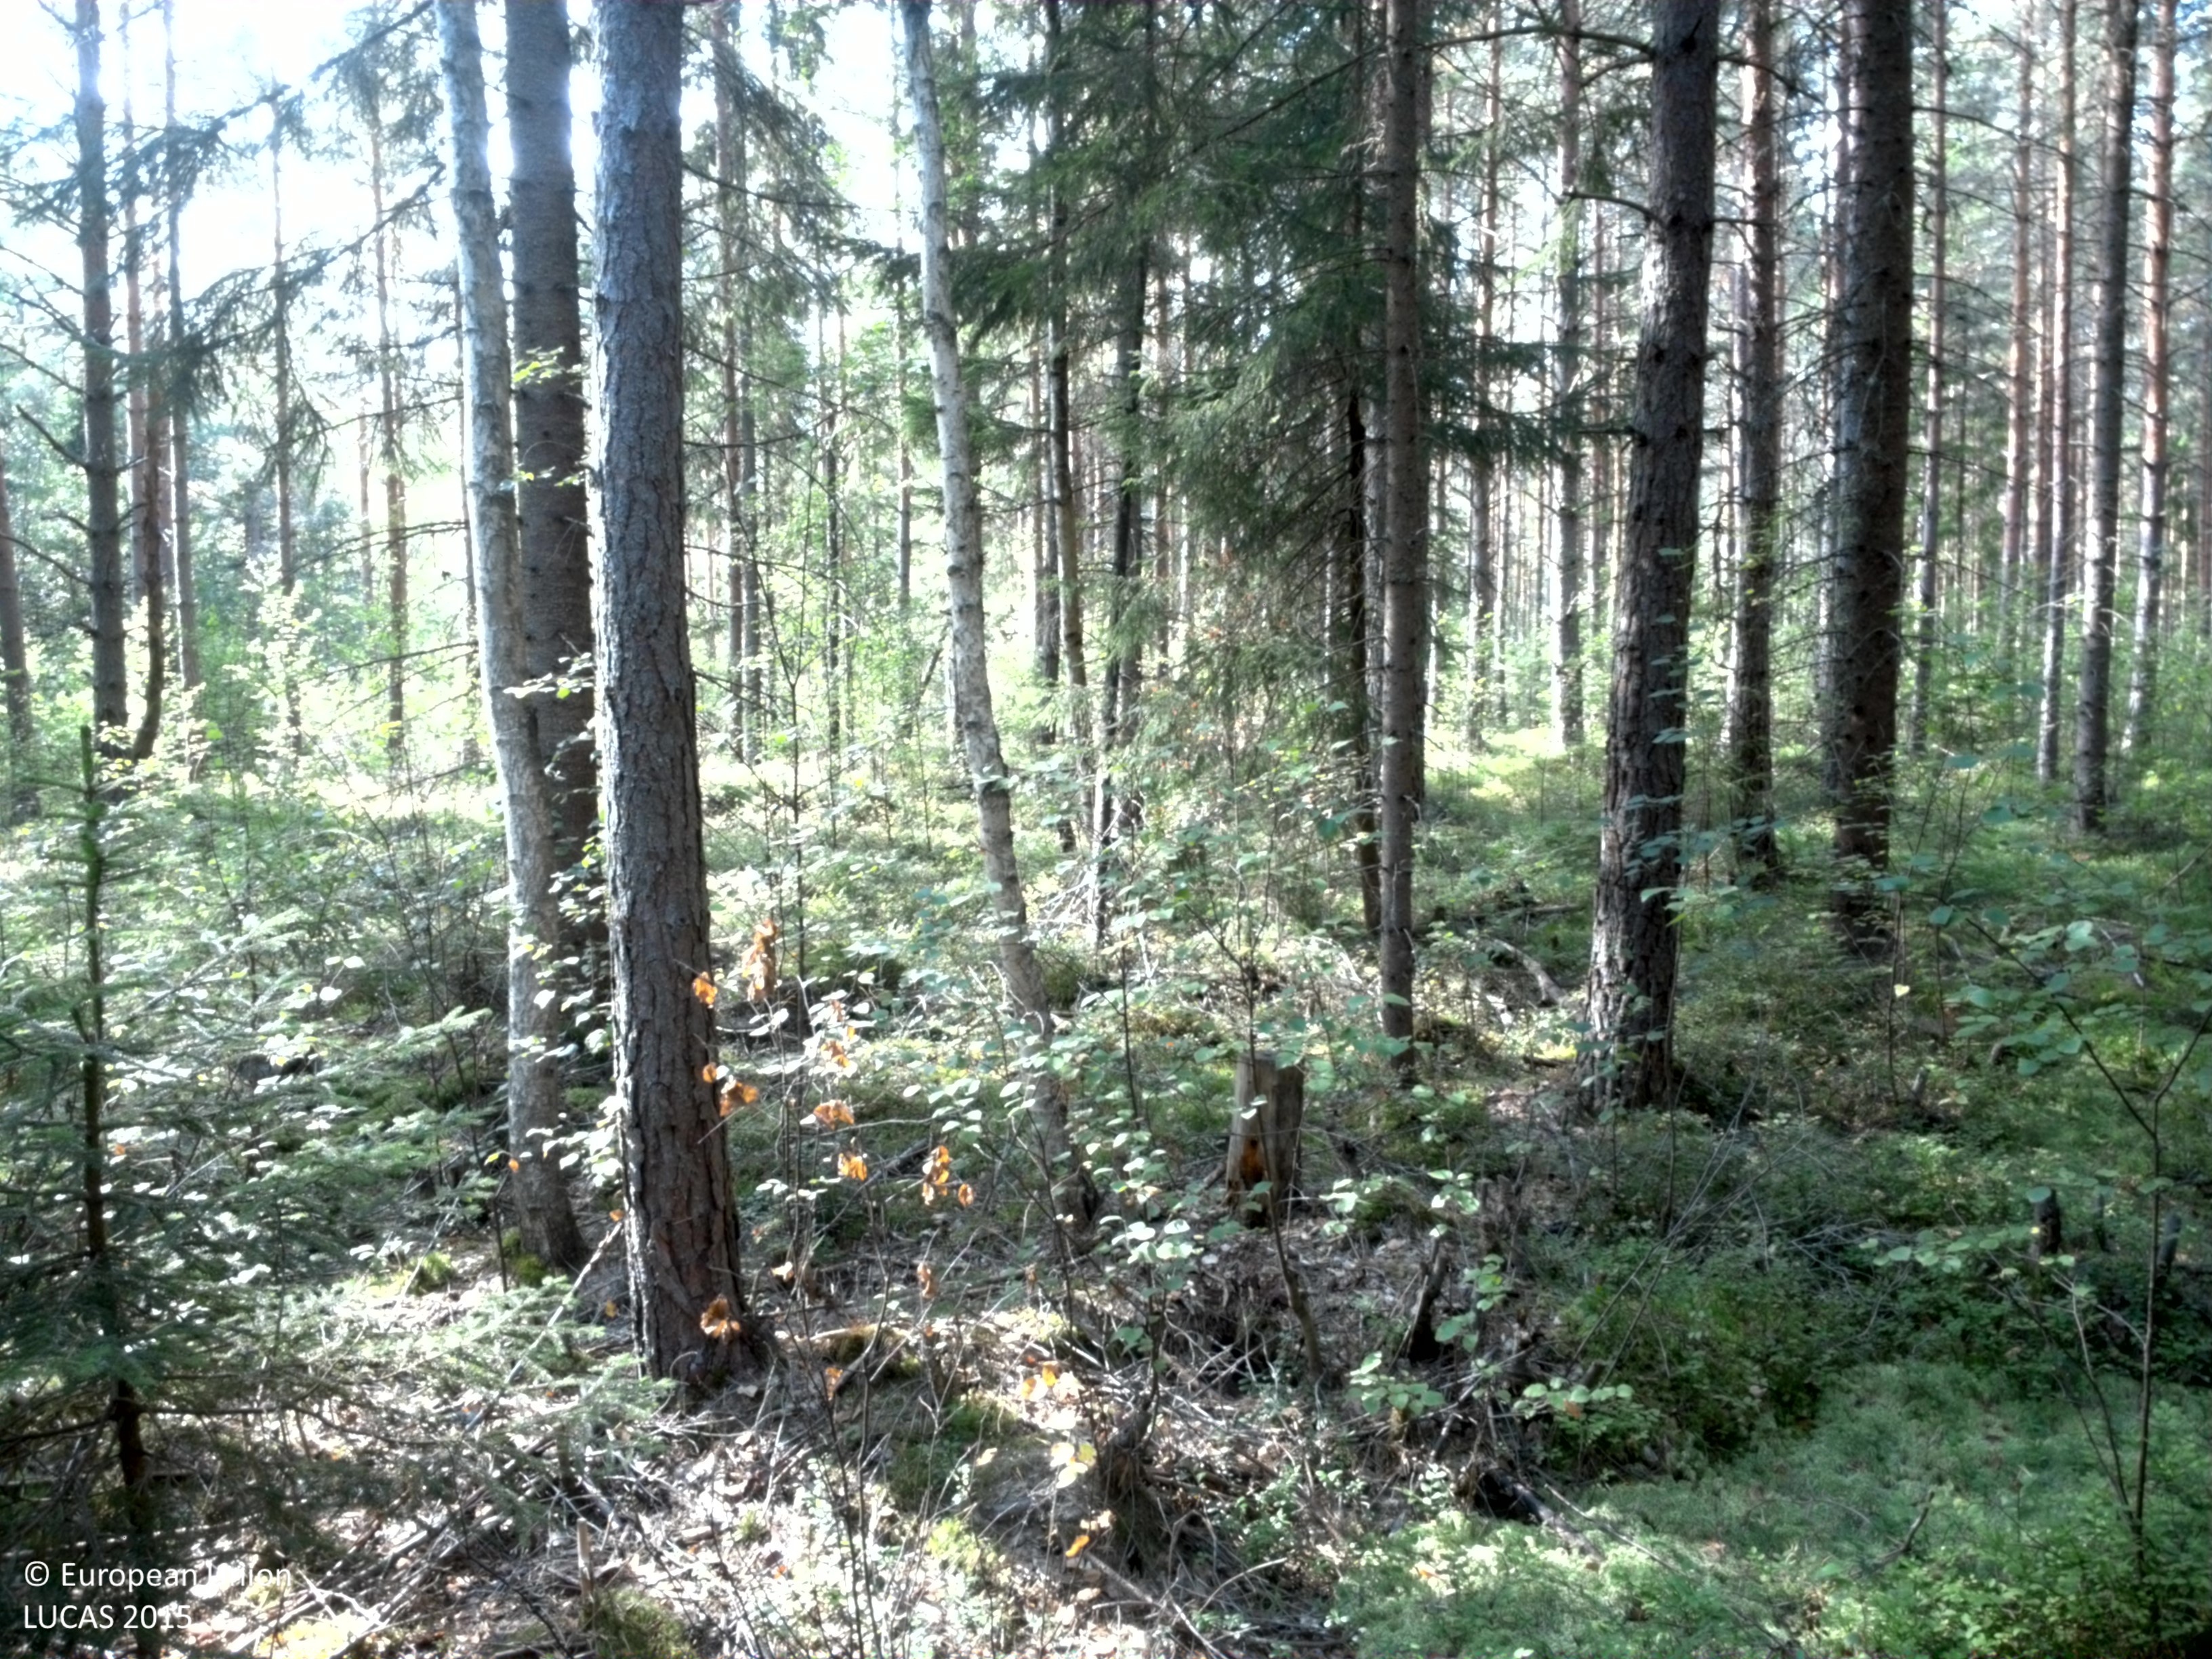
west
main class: Woodland
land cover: Pine dominated coniferous woodland
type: boreal forest
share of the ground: > 75 %
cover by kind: coniferous forest trees 70 %, shrubs 15 %, broadleaved forest trees 10 %, lichens and mosses 5 %
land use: Forestry
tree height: > 5 m
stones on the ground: < 10 %
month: August
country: SE
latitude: 59.8302
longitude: 15.7164
